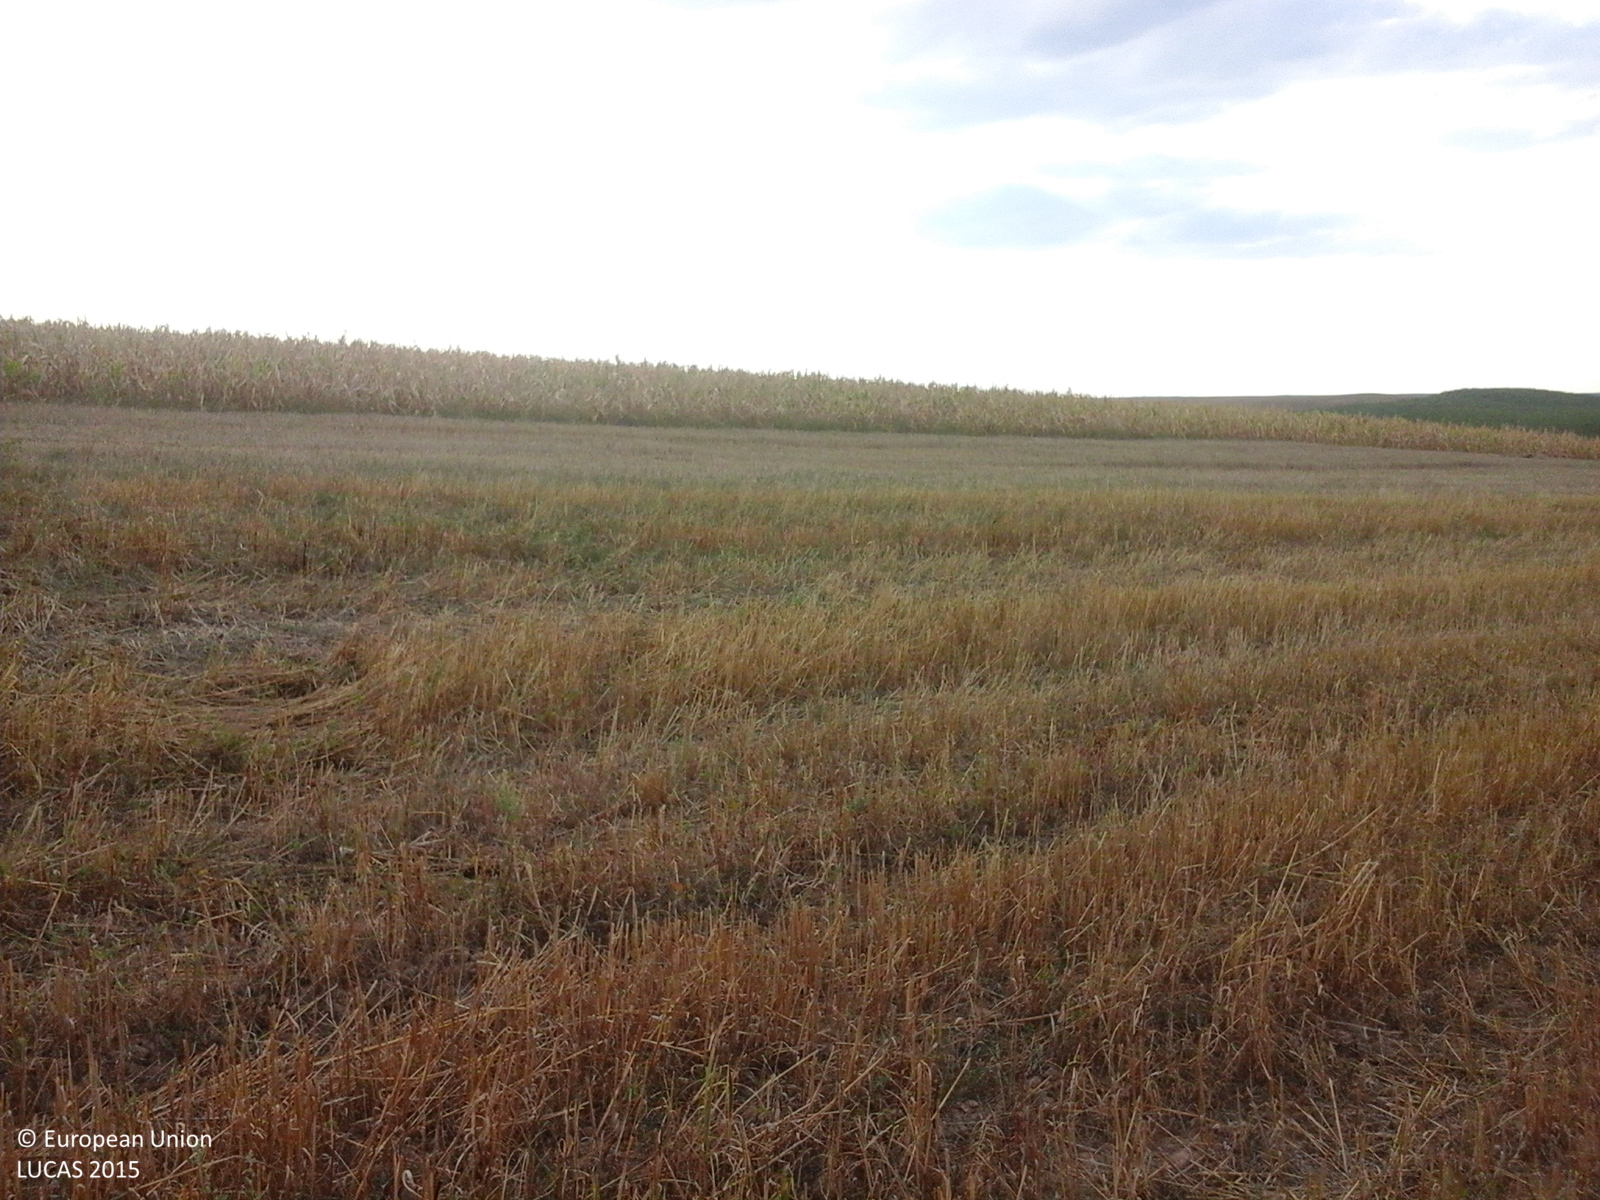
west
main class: Cropland
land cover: Oats
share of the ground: 50 - 75 %
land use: Agriculture (excluding fallow land and kitchen gardens)
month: September
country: RO
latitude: 47.6043
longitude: 22.9270
